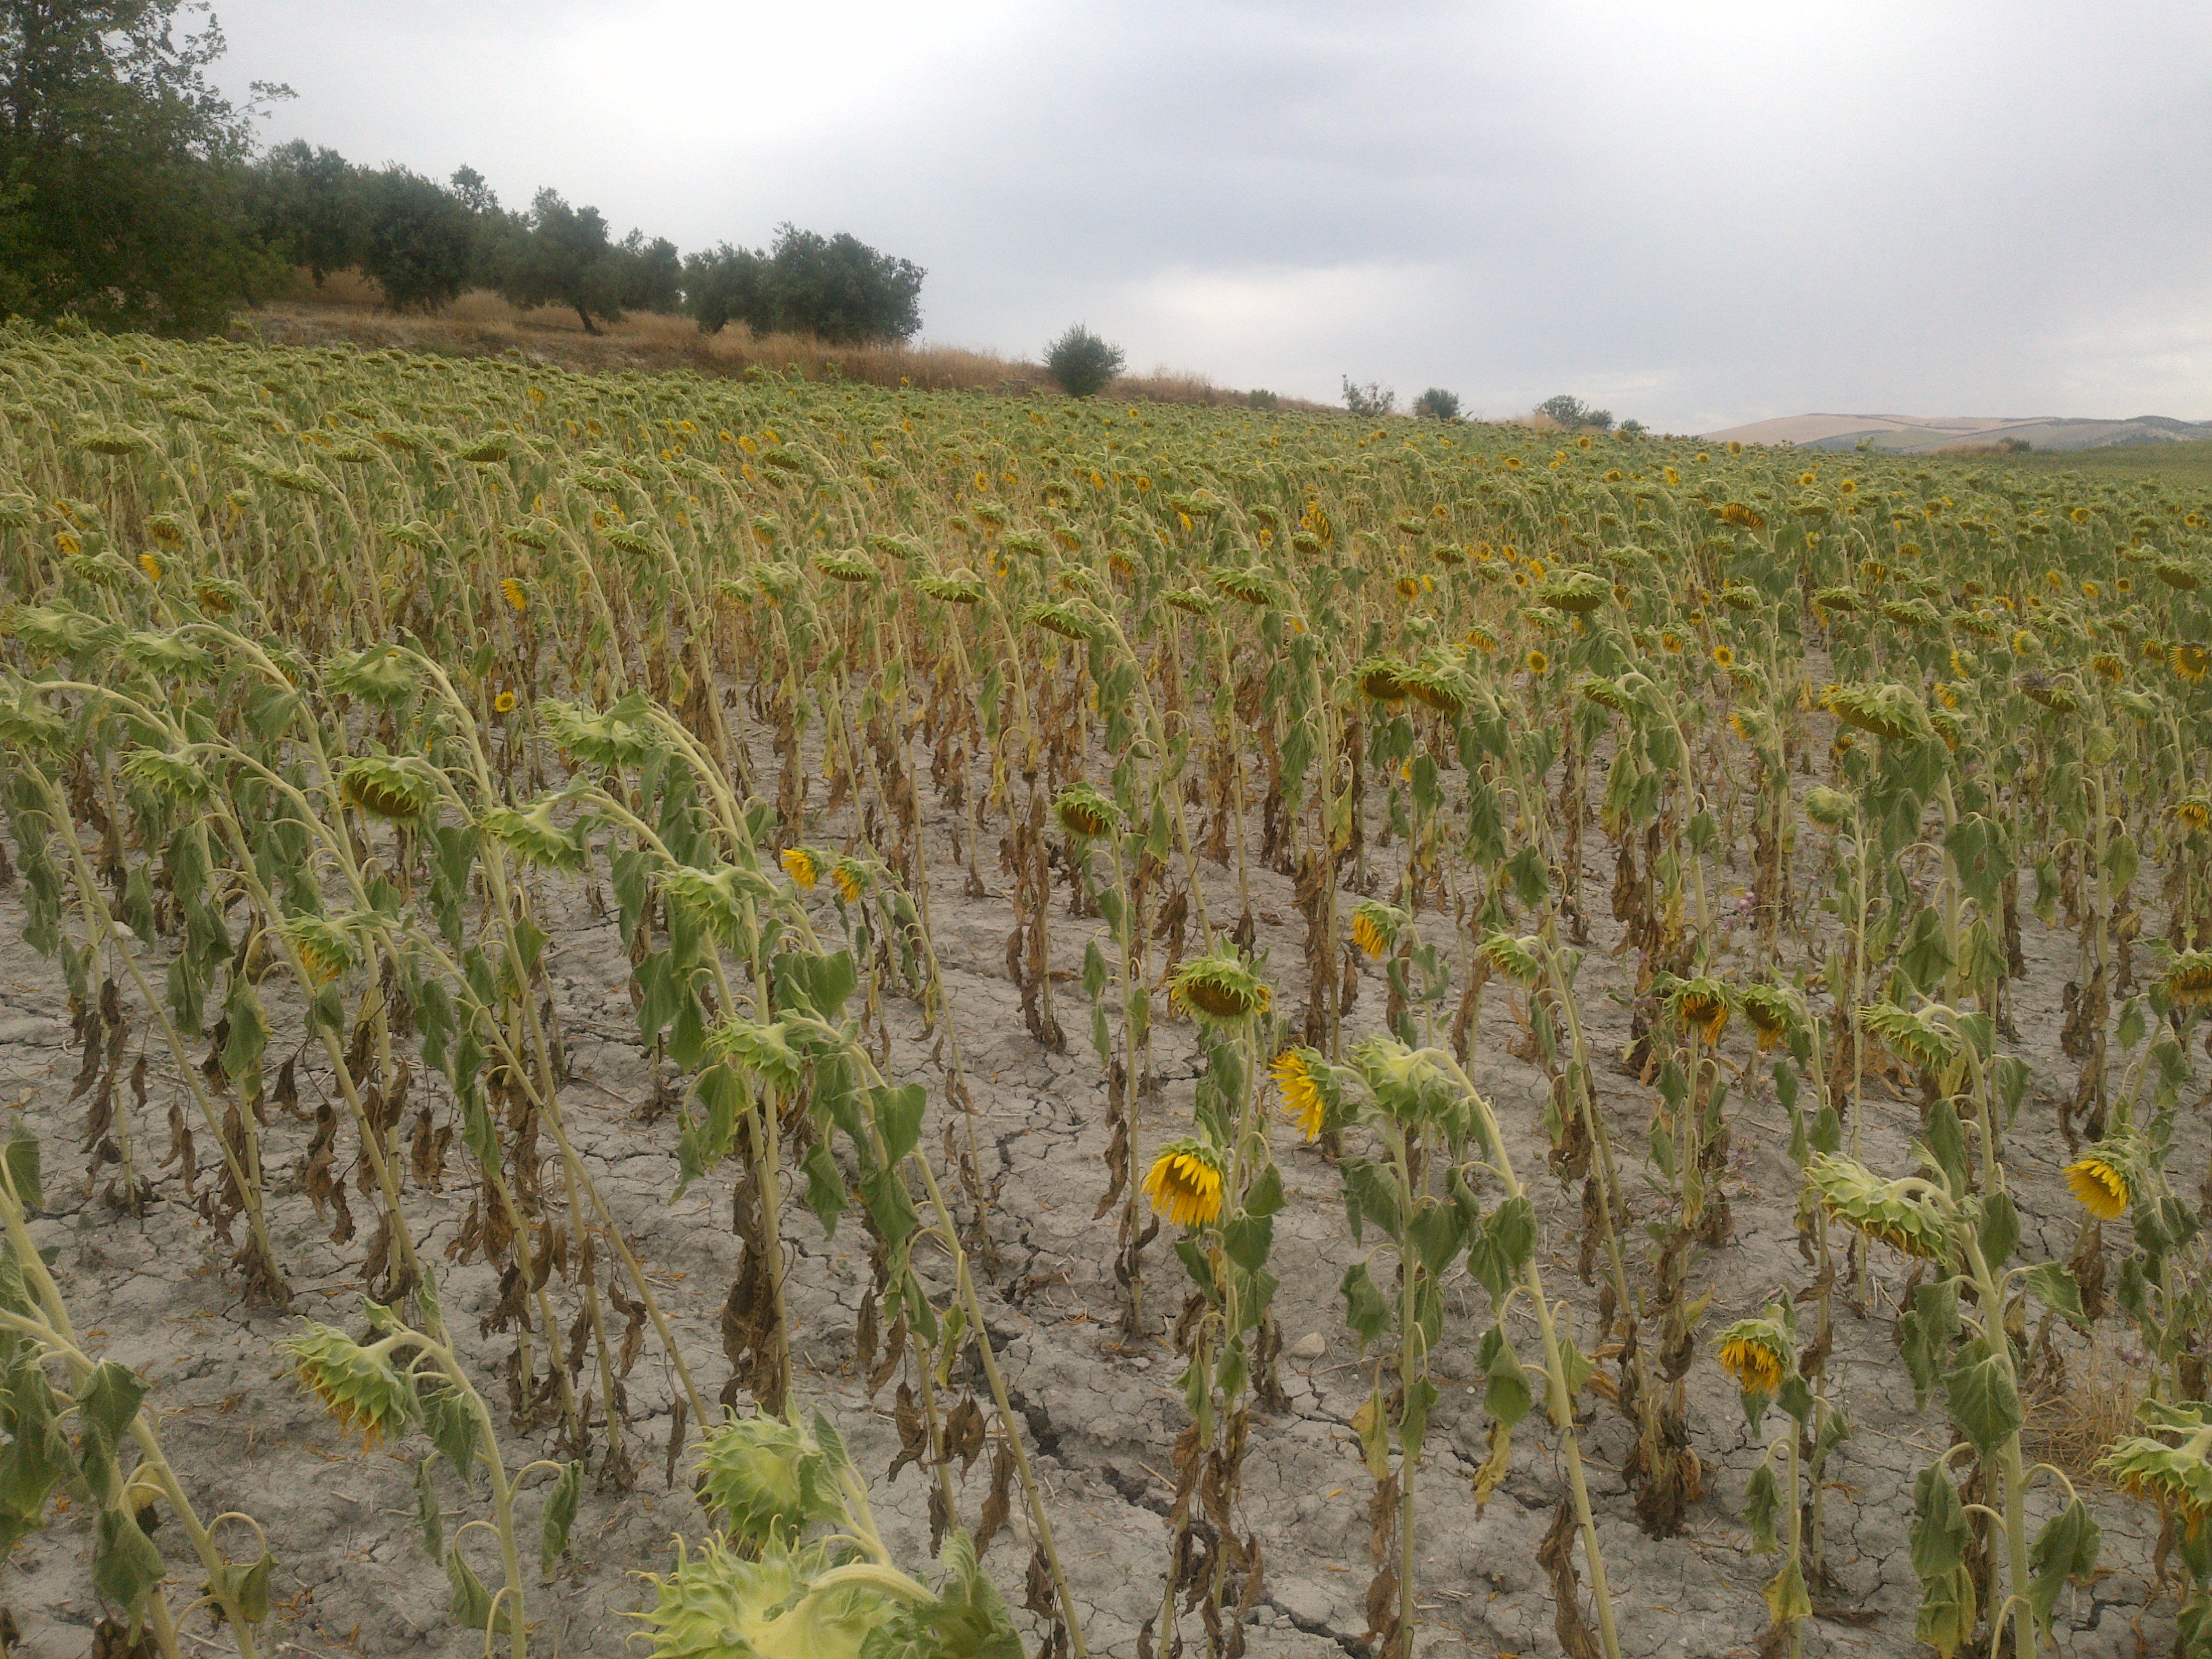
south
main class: Cropland
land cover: Sunflower
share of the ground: 25 - 50 %
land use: Agriculture (excluding fallow land and kitchen gardens)
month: June
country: ES
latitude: 37.7654
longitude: -4.5281
